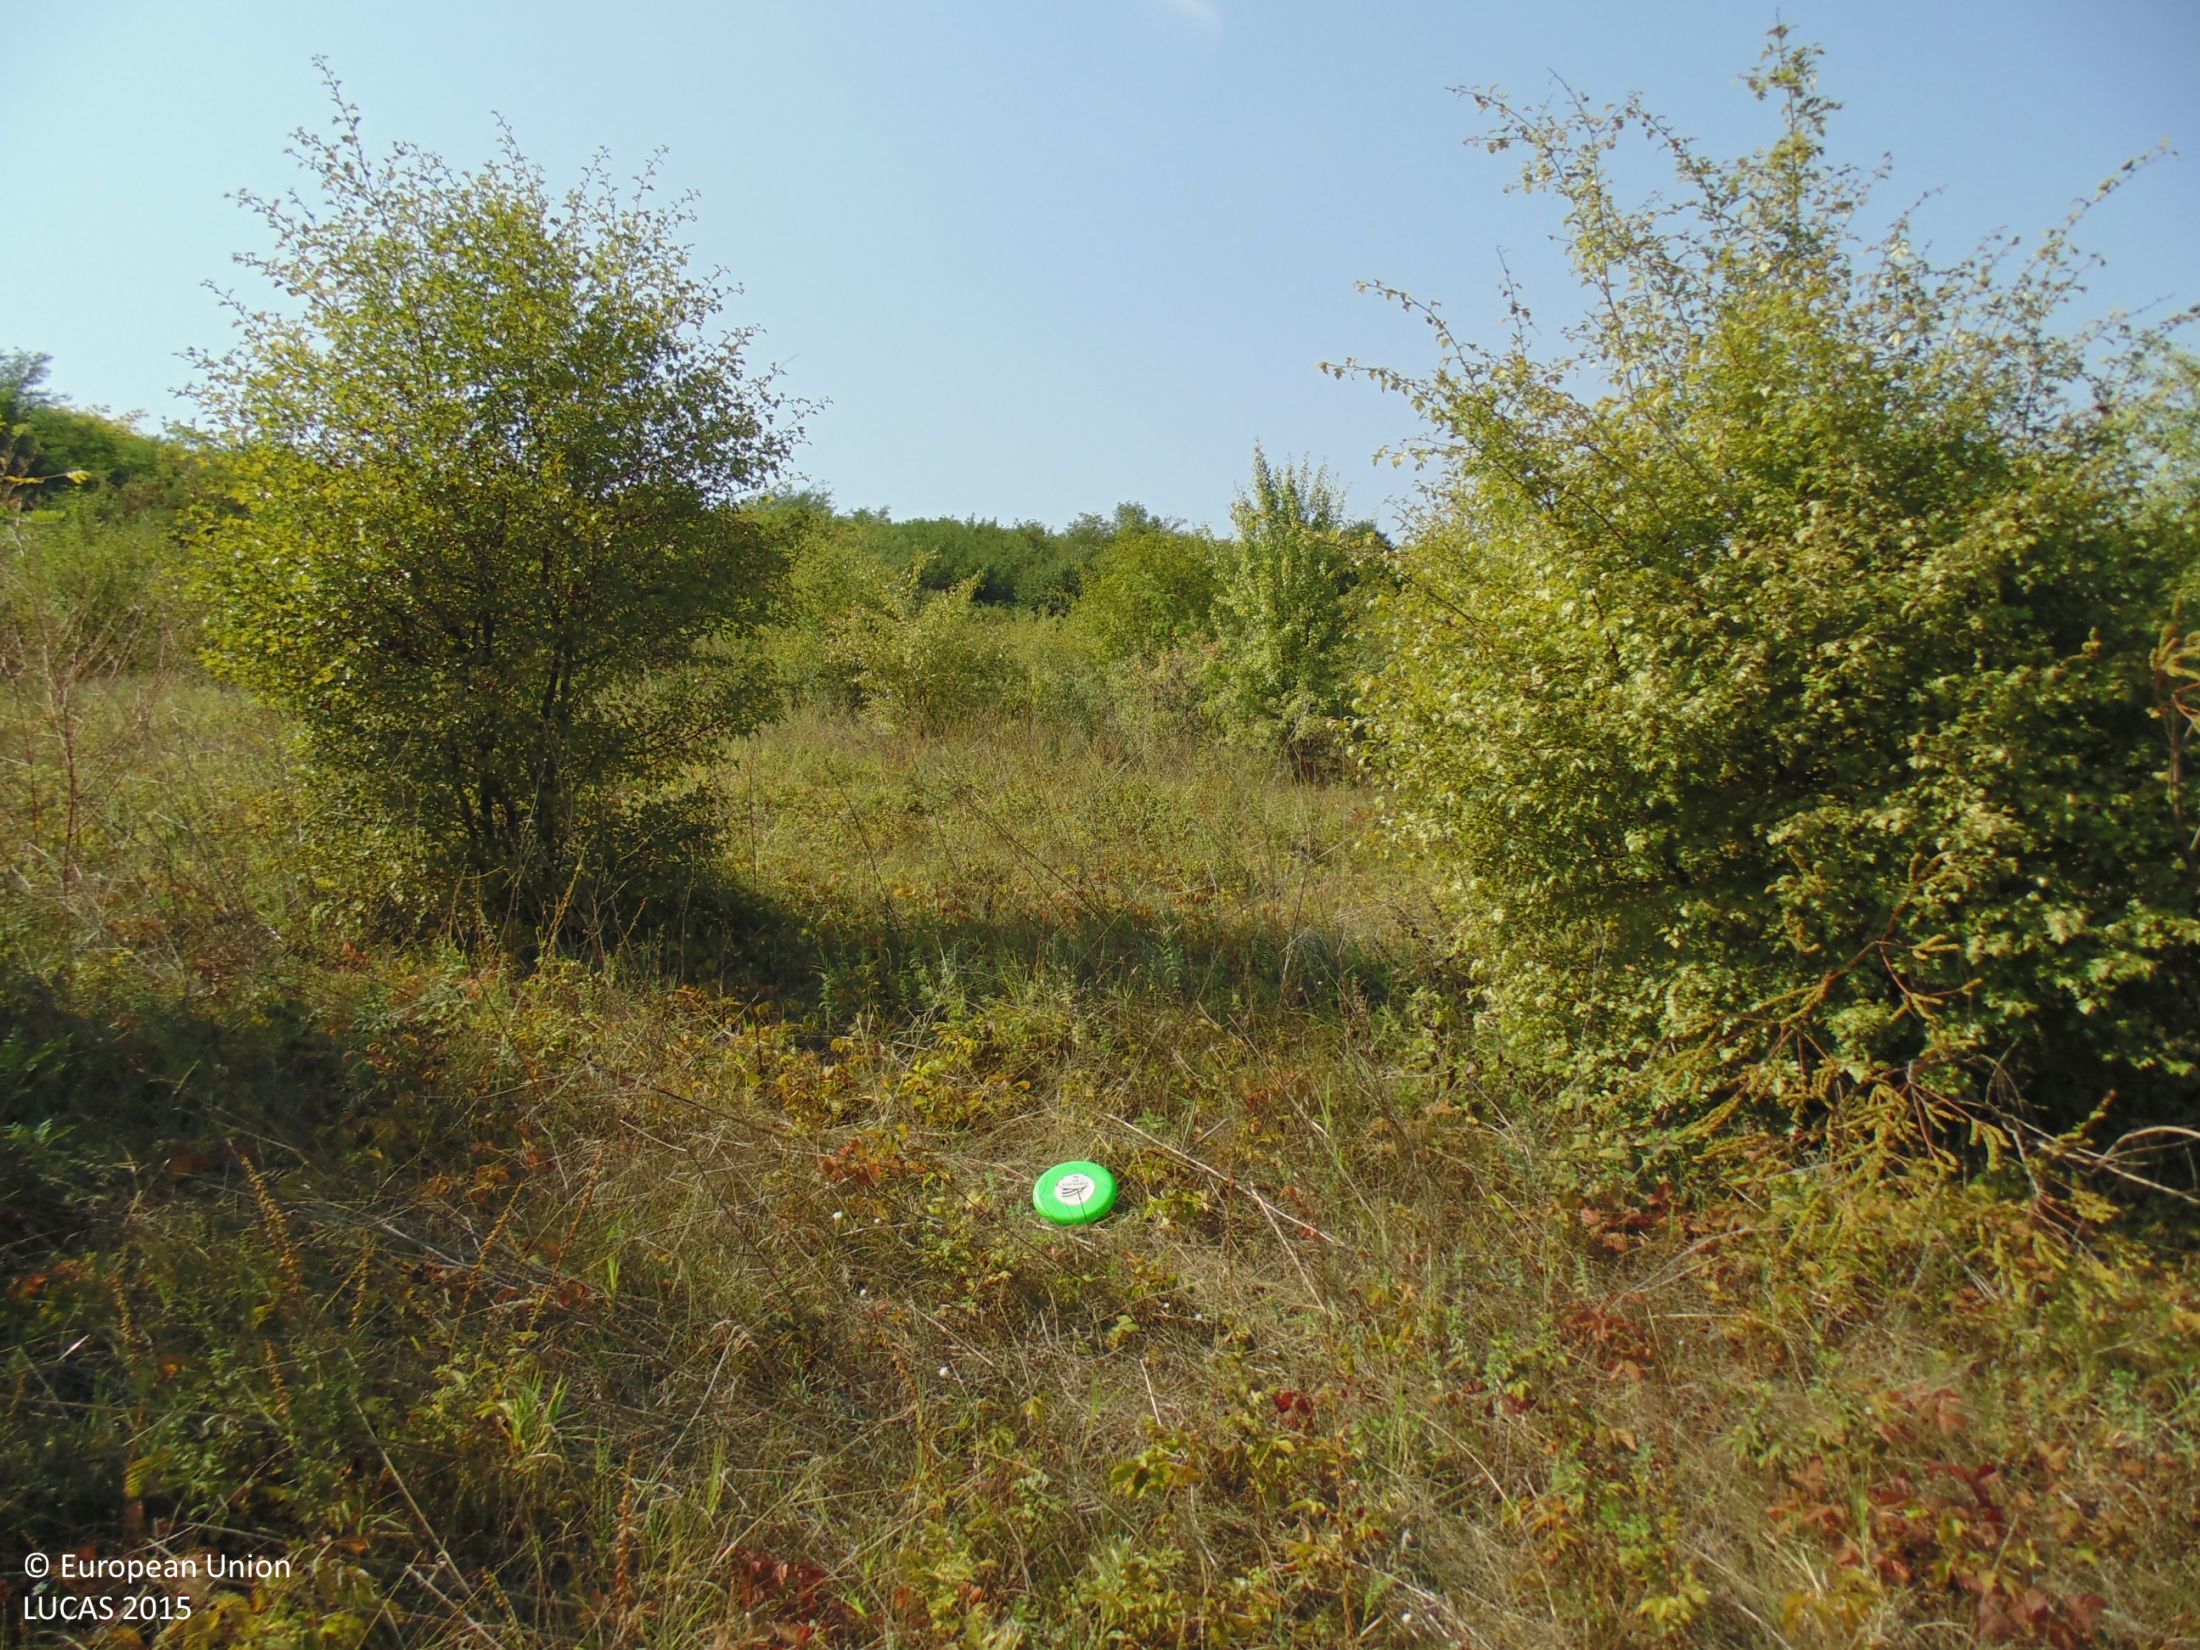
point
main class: Grassland
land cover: Grassland with sparse tree/shrub cover
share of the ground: > 75 %
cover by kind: herbaceous plants 90 %, broadleaved forest trees 5 %, shrubs 5 %
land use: Abandoned areas
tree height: < 5 m
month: August
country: BG
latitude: 43.9588
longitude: 27.3682
